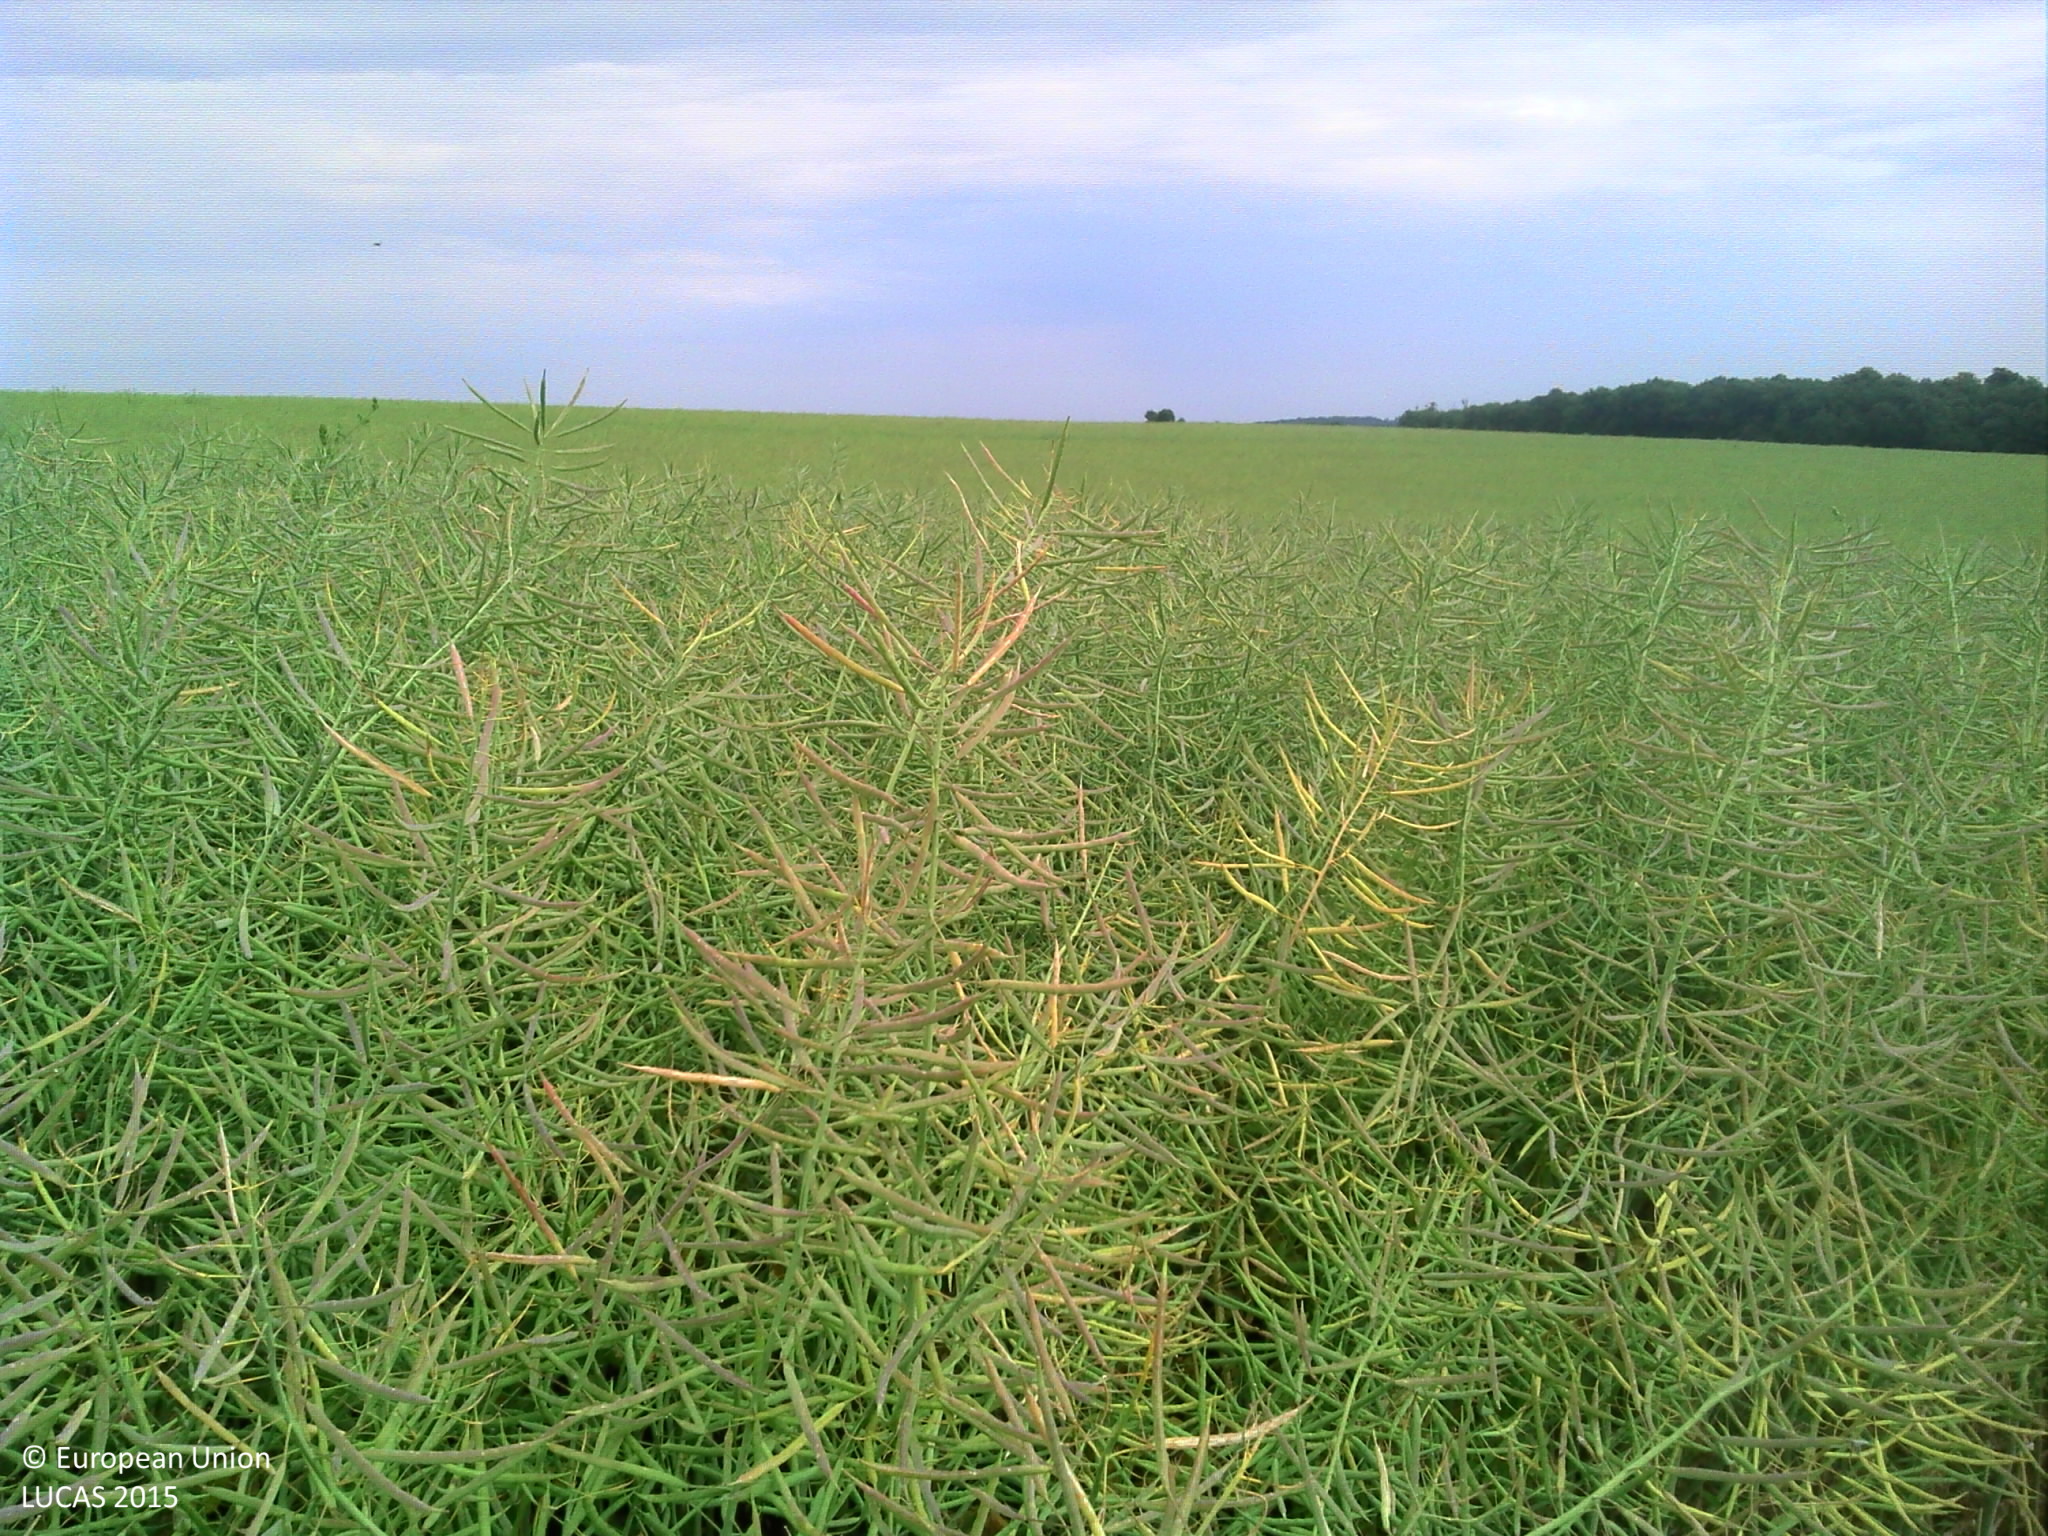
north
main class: Cropland
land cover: Rape and turnip rape
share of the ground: > 75 %
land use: Agriculture (excluding fallow land and kitchen gardens)
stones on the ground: 10 - 25 %
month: June
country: FR
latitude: 48.3788
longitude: 4.9624
